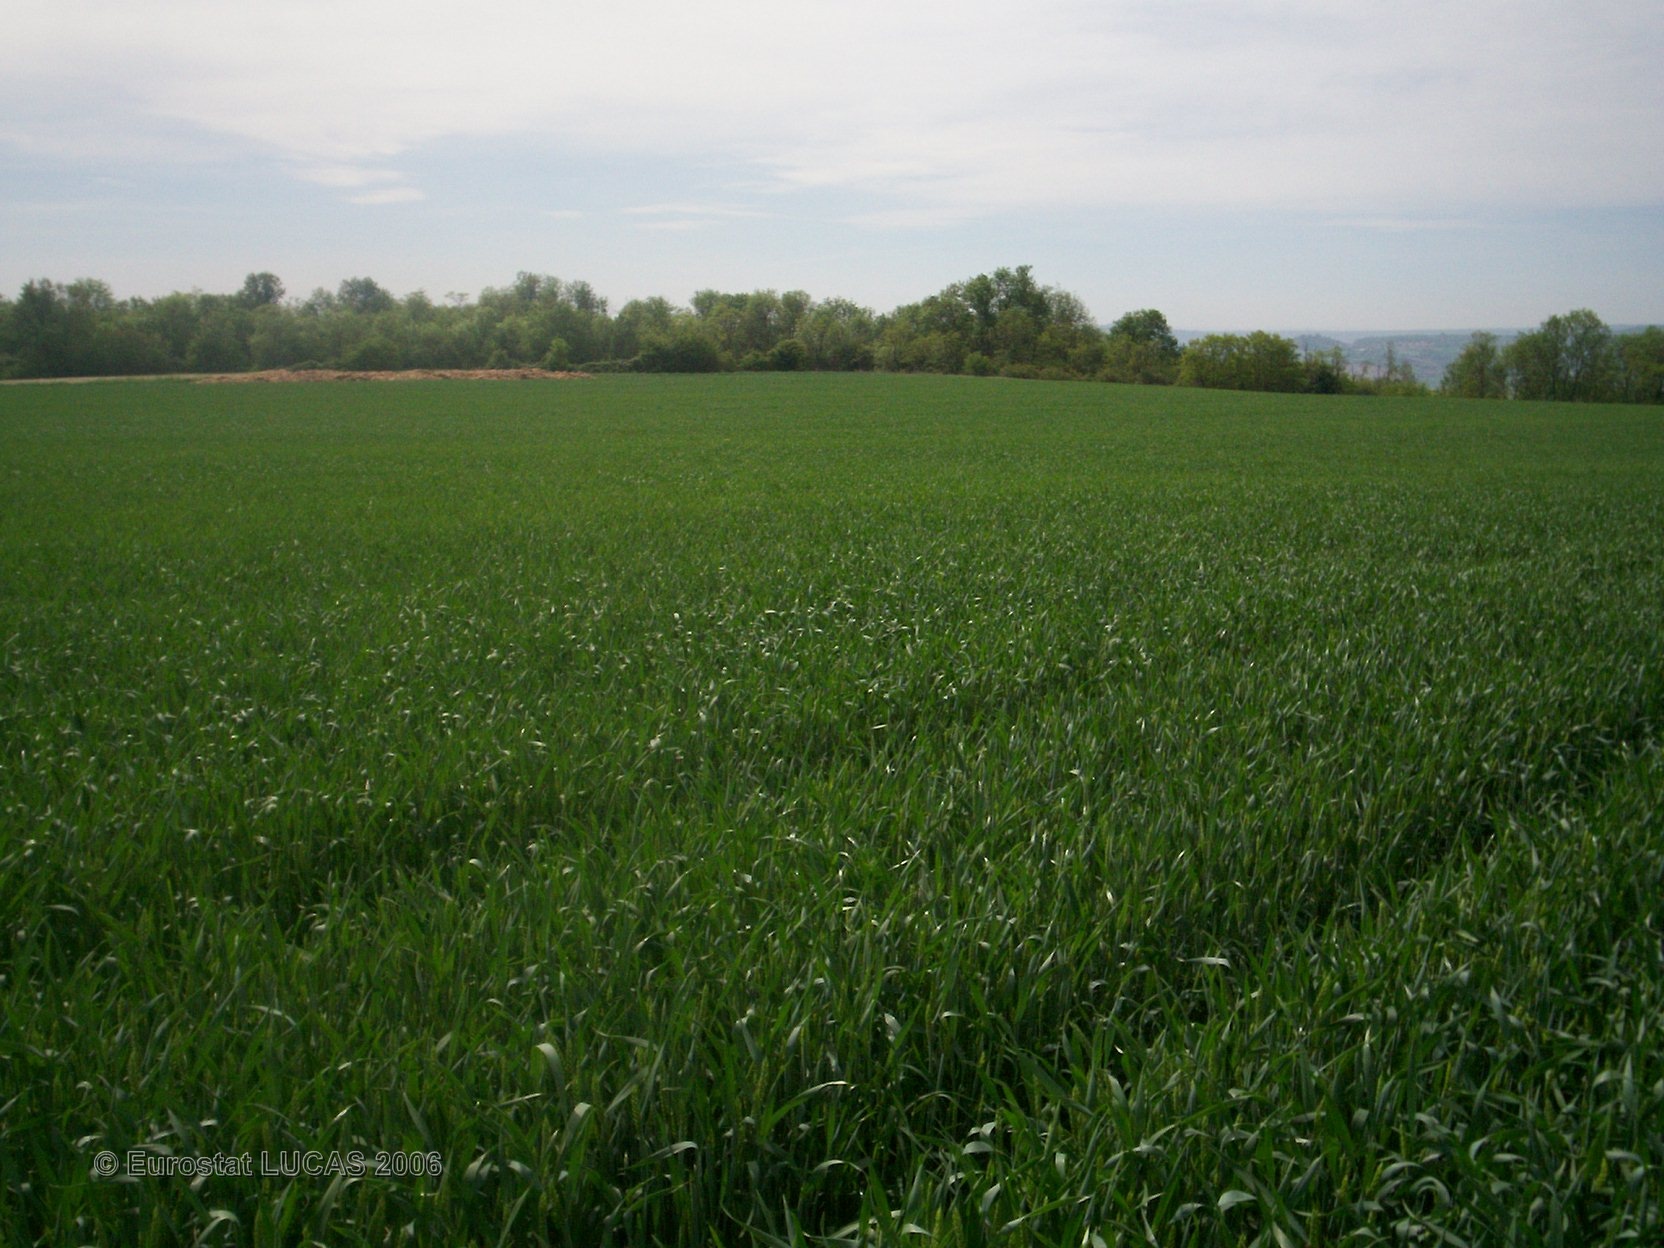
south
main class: Cropland
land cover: Common wheat
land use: Agriculture (excluding fallow land and kitchen gardens)
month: May
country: FR
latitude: 45.5203
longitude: 3.2029
